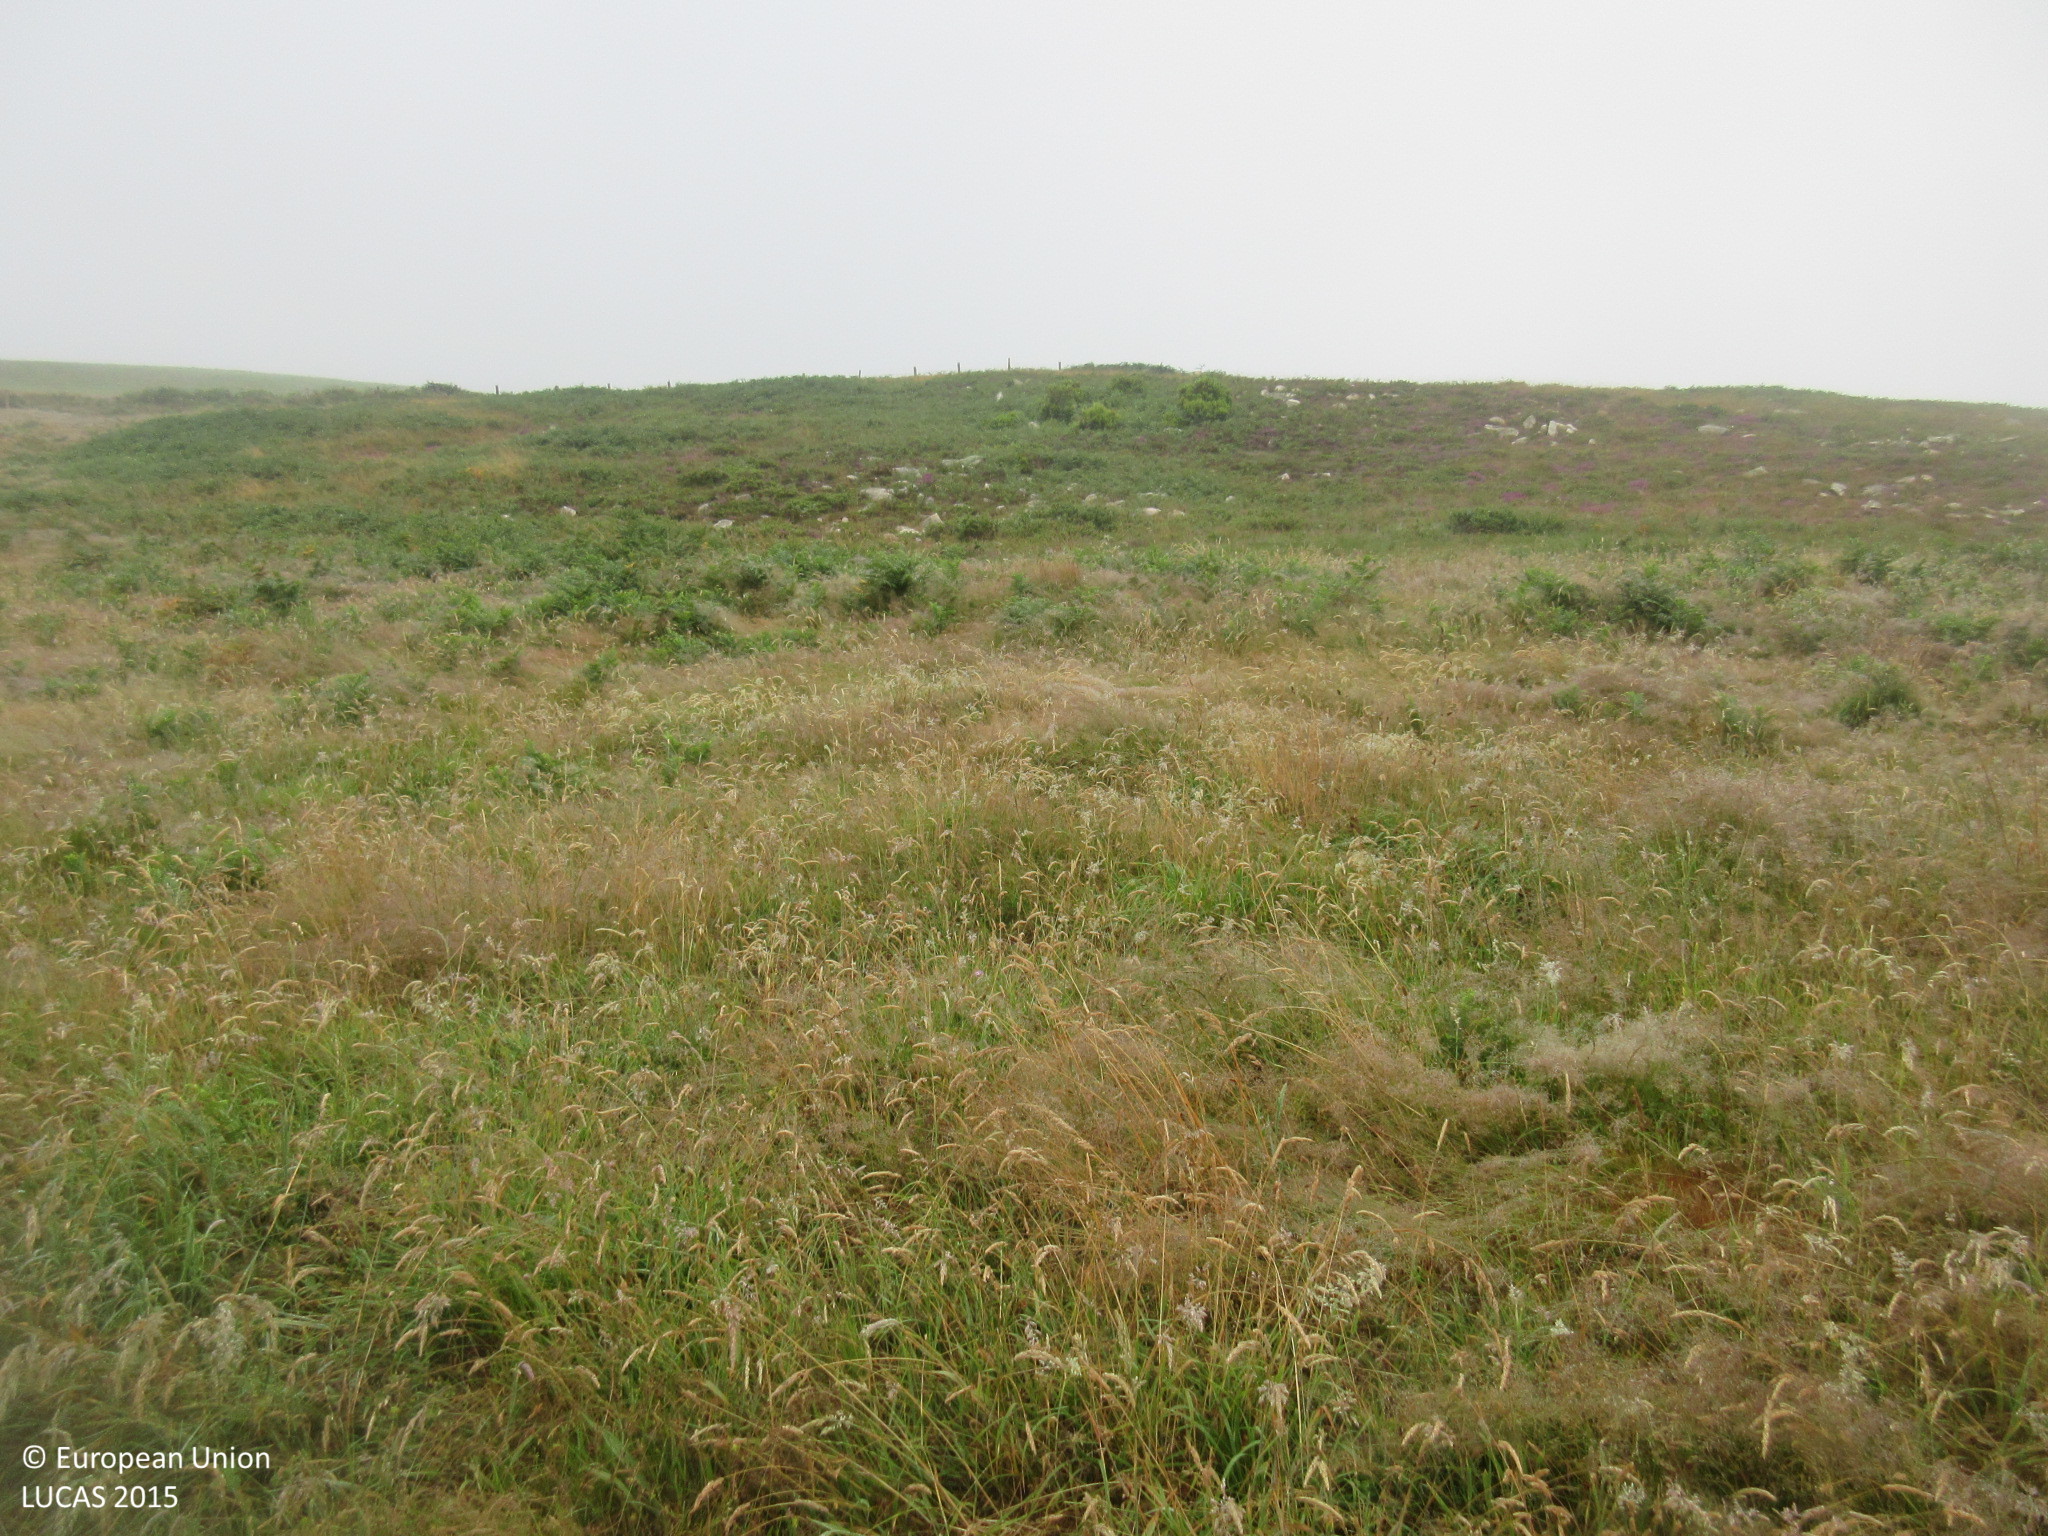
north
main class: Grassland
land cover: Grassland without tree/shrub cover
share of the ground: > 75 %
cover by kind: herbaceous plants 100 %
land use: Agriculture (excluding fallow land and kitchen gardens)
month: July
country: ES
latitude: 43.3245
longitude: -6.3144
